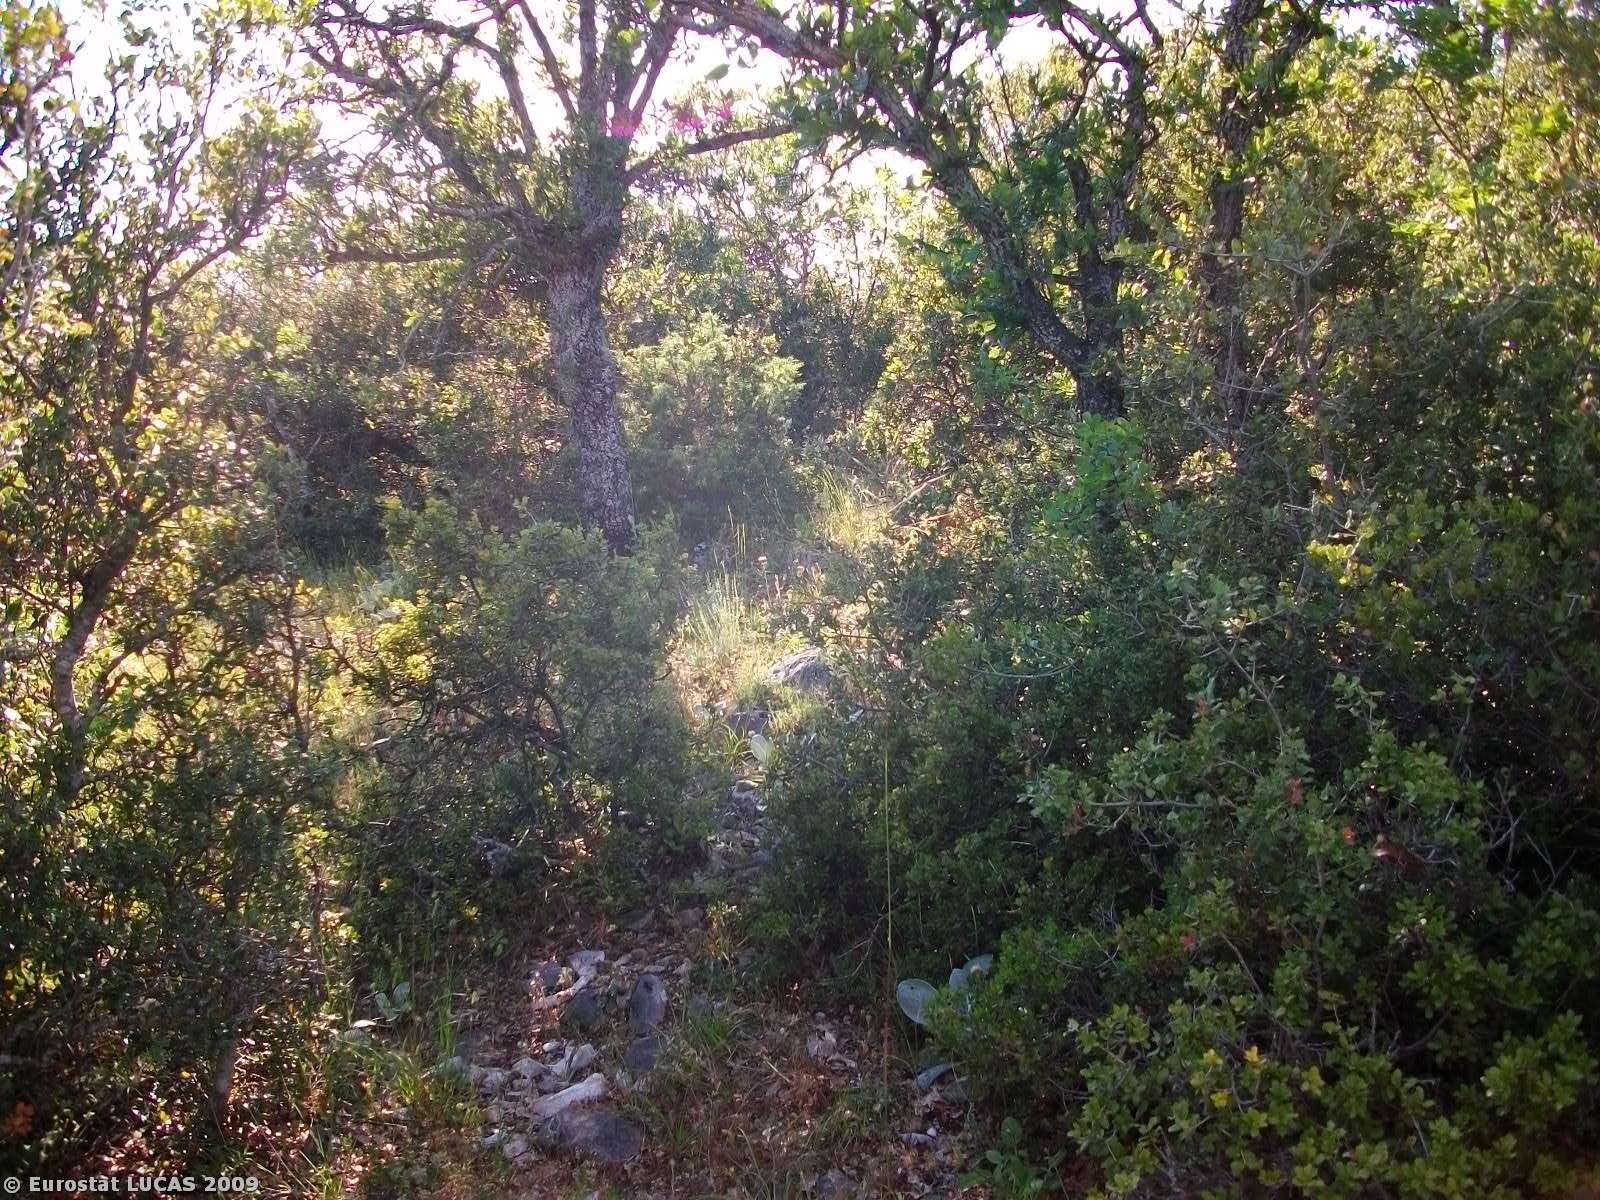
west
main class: Woodland
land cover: Broadleaved woodland
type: thermophilous deciduous forest
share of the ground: > 75 %
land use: Forestry
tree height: > 5 m
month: June
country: GR
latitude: 39.9959
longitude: 21.7594
